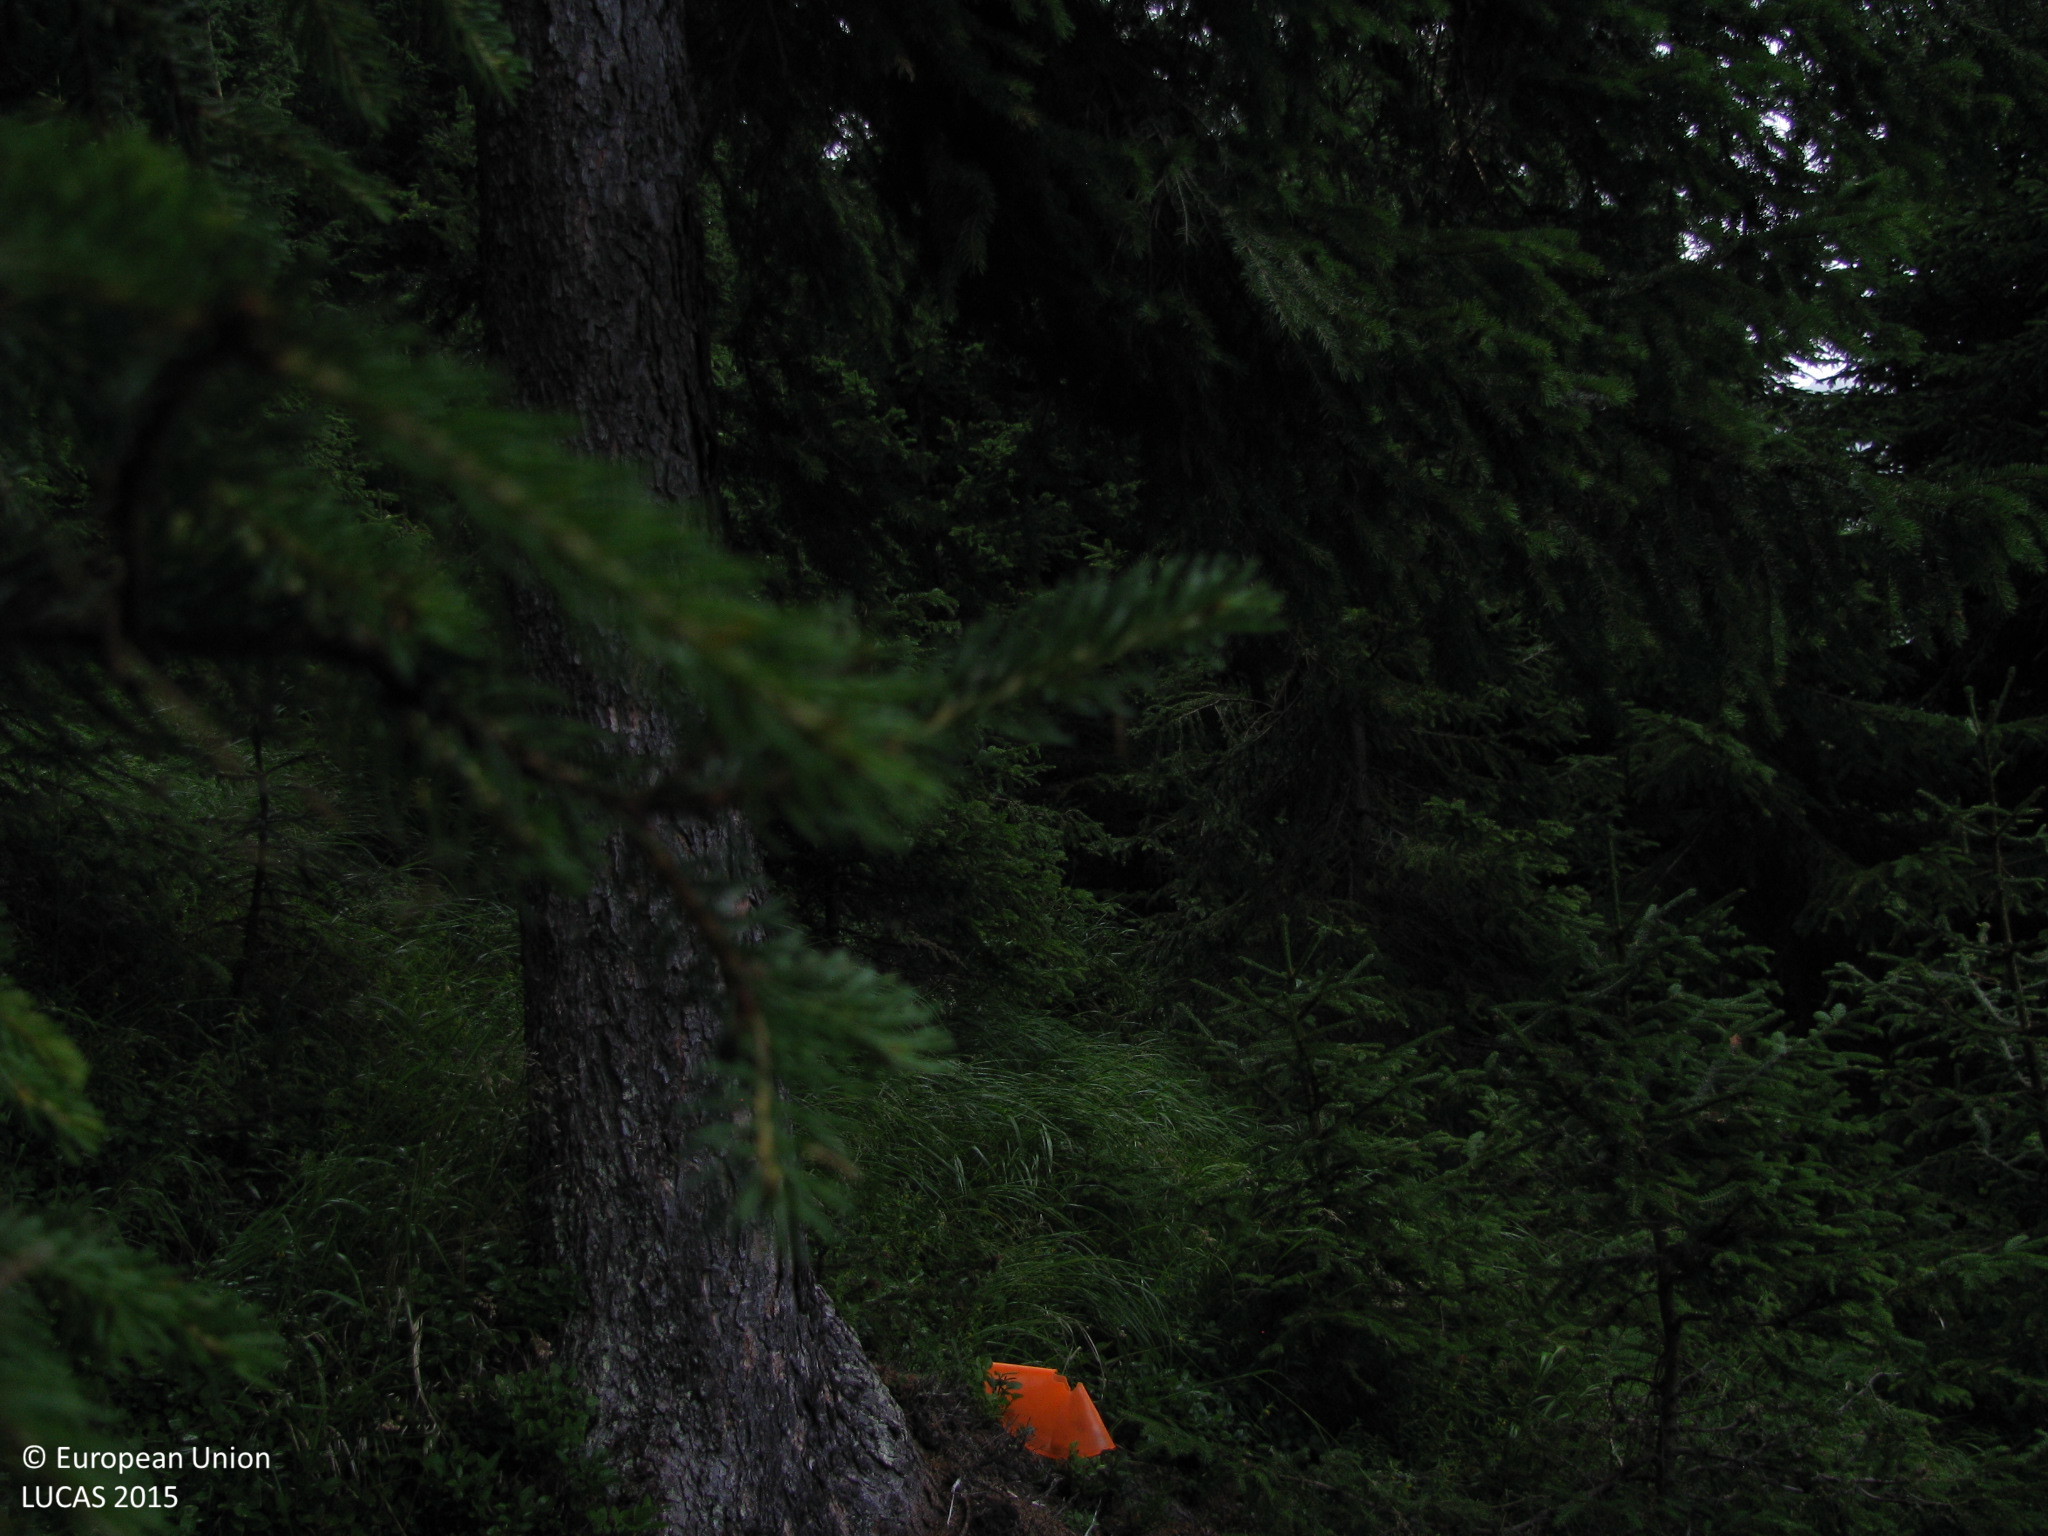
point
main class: Woodland
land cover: Spruce dominated coniferous woodland
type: alpine coniferous forest
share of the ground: > 75 %
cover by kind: coniferous forest trees 85 %, herbaceous plants 15 %
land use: Forestry
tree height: > 5 m
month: July
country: AT
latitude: 46.6974
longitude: 12.6261
